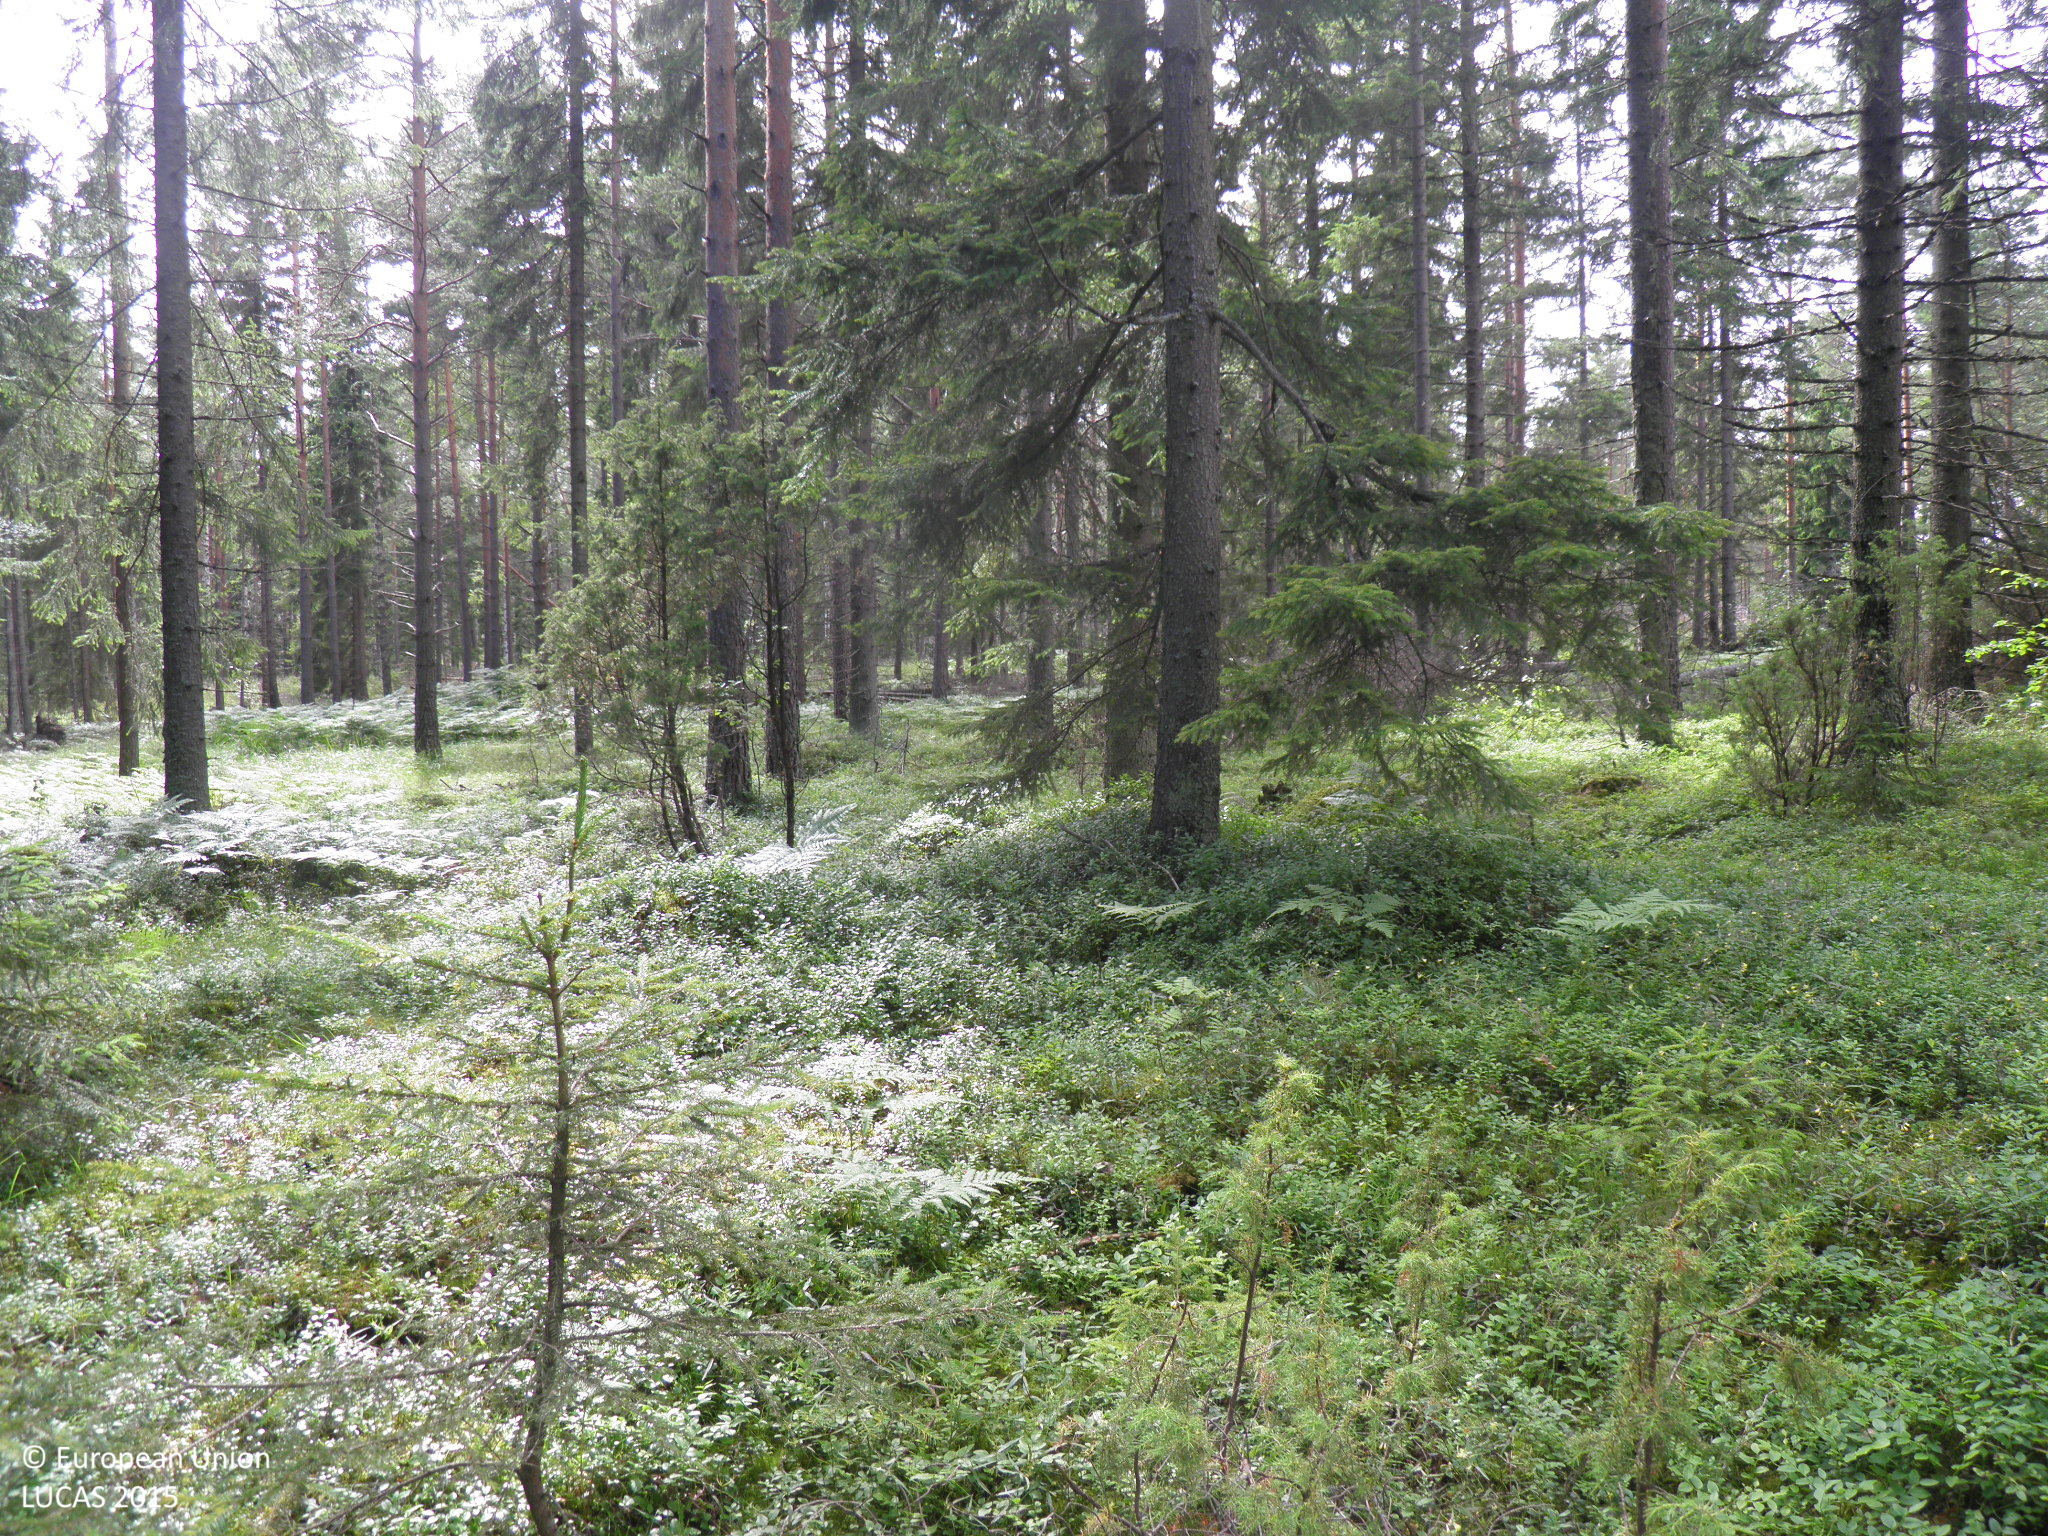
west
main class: Woodland
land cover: Spruce dominated coniferous woodland
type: boreal forest
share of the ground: 50 - 75 %
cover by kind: shrubs 50 %, coniferous forest trees 40 %, broadleaved forest trees 10 %
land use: Forestry
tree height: > 5 m
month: July
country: FI
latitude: 60.0583
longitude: 22.5208
